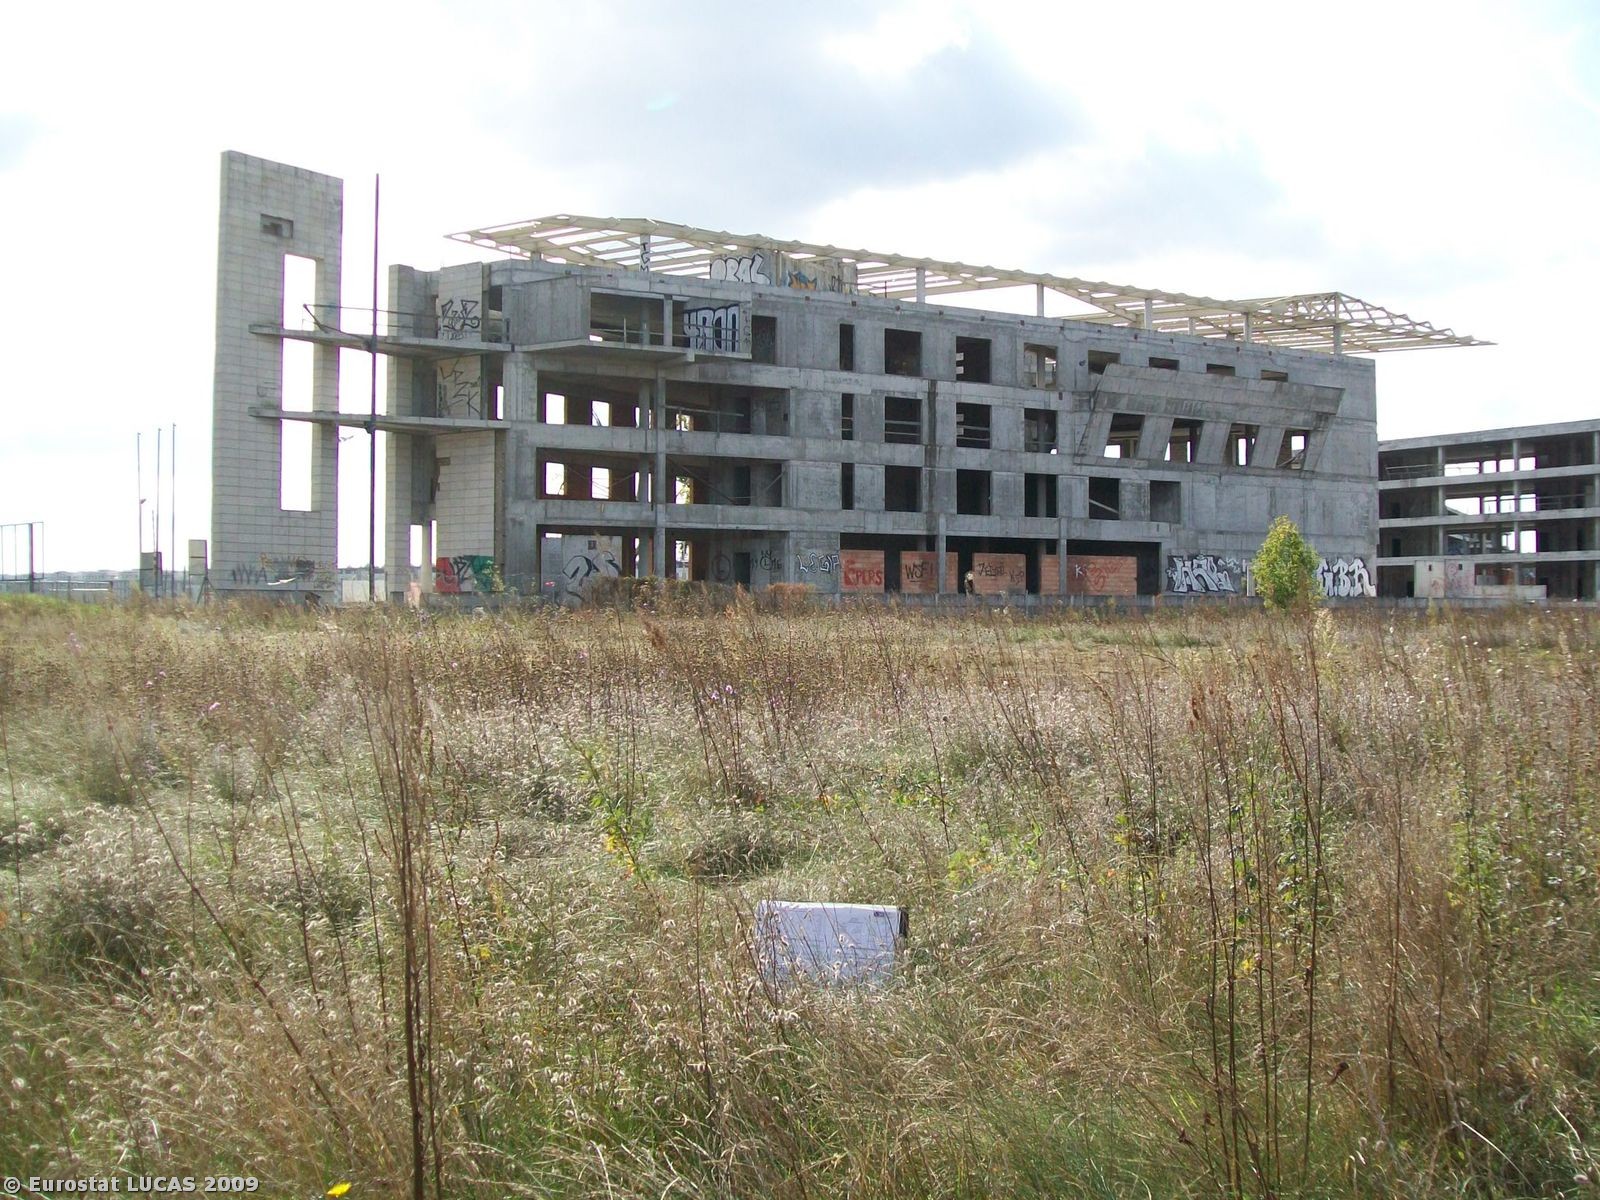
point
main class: Grassland
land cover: Grassland without tree/shrub cover
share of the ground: > 75 %
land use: Unused
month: September
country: PL
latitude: 52.1653
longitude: 21.0834
